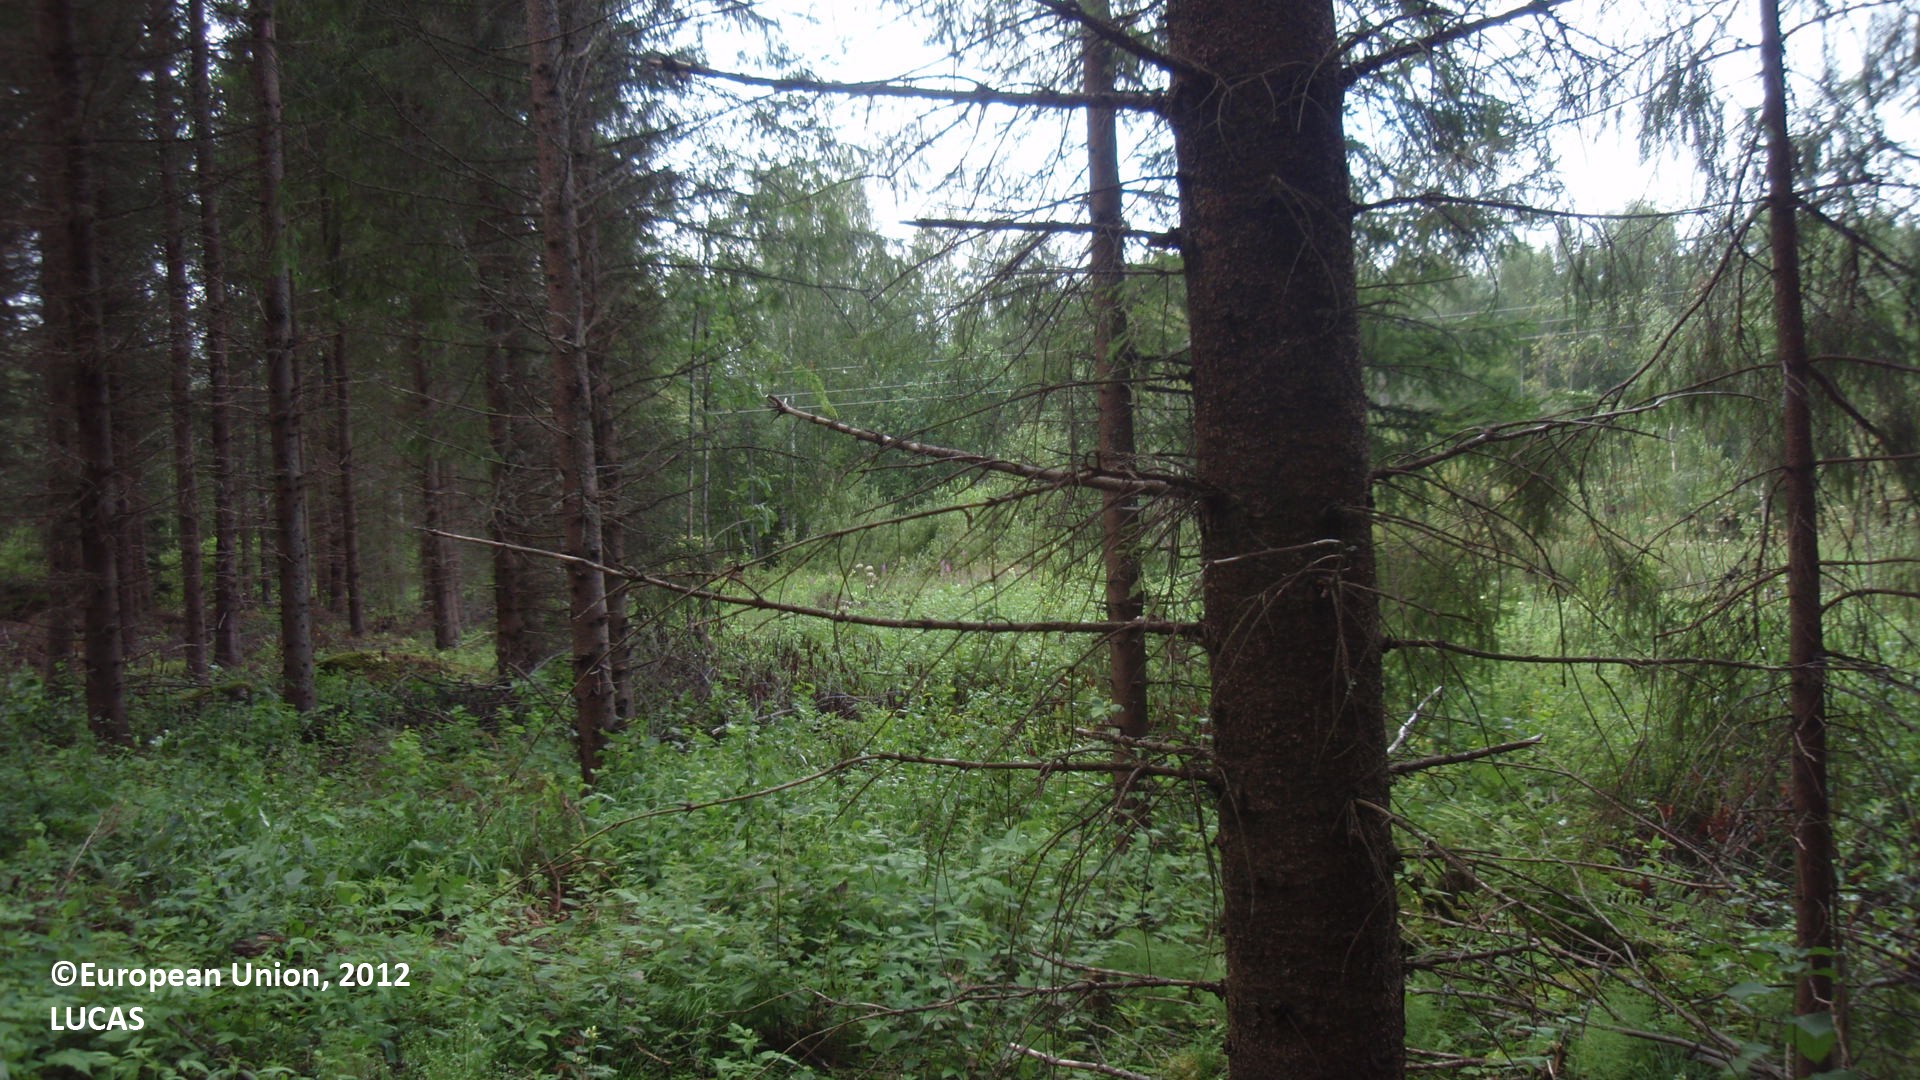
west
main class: Woodland
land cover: Spruce dominated coniferous woodland
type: boreal forest
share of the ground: 50 - 75 %
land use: Forestry
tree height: > 5 m
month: August
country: FI
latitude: 61.0369
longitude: 27.6437
